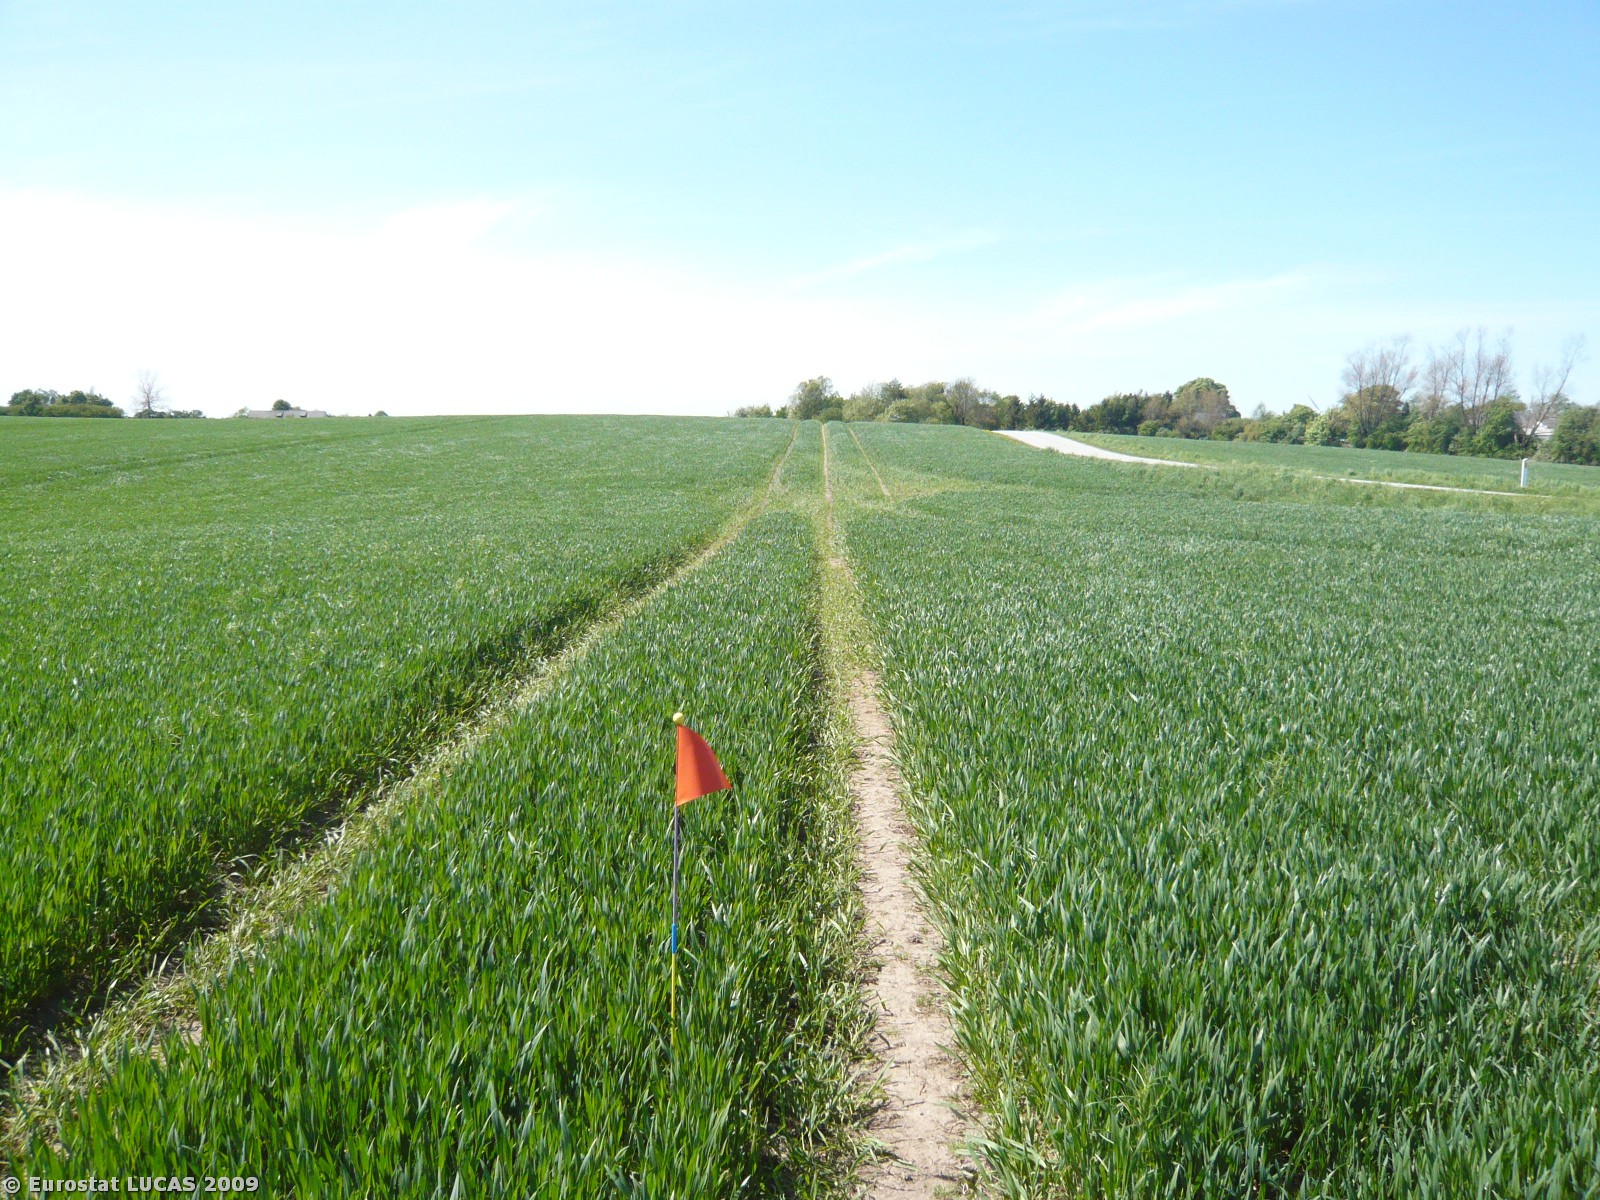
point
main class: Cropland
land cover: Common wheat
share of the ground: > 75 %
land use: Agriculture (excluding fallow land and kitchen gardens)
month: May
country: DK
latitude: 55.2383
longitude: 11.9329
